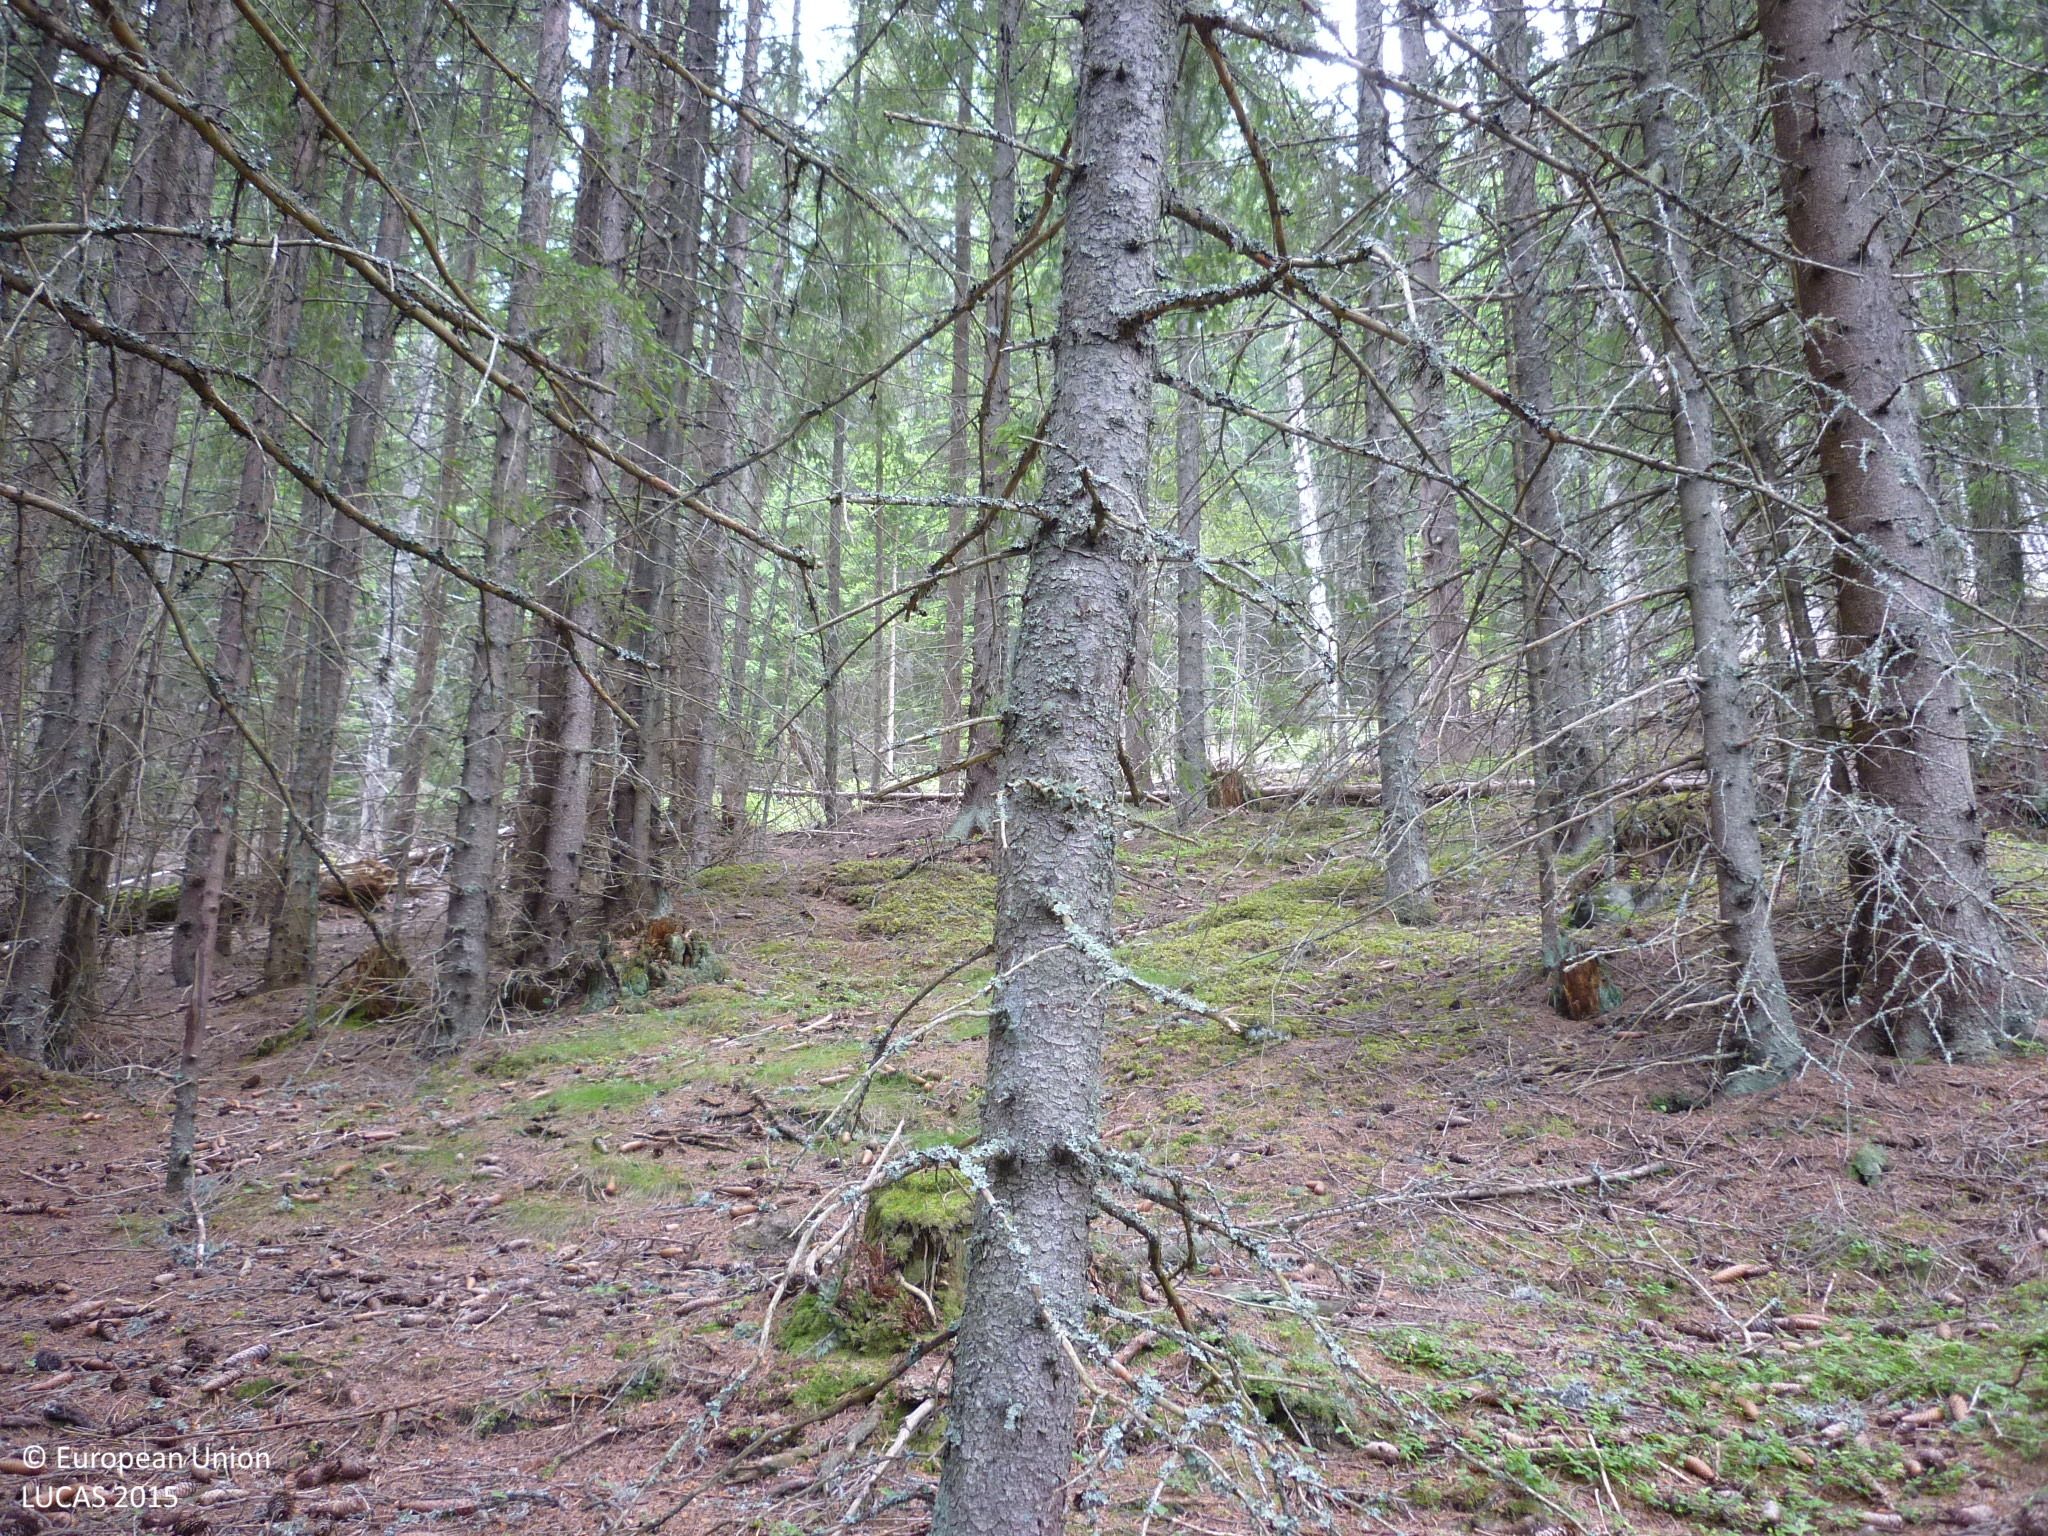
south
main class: Woodland
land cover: Spruce dominated coniferous woodland
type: alpine coniferous forest
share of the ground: > 75 %
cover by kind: coniferous forest trees 90 %, herbaceous plants 5 %, unconsolidated bare surface 5 %
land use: Forestry
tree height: > 5 m
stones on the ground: < 10 %
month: June
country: AT
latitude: 47.1860
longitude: 14.2610
